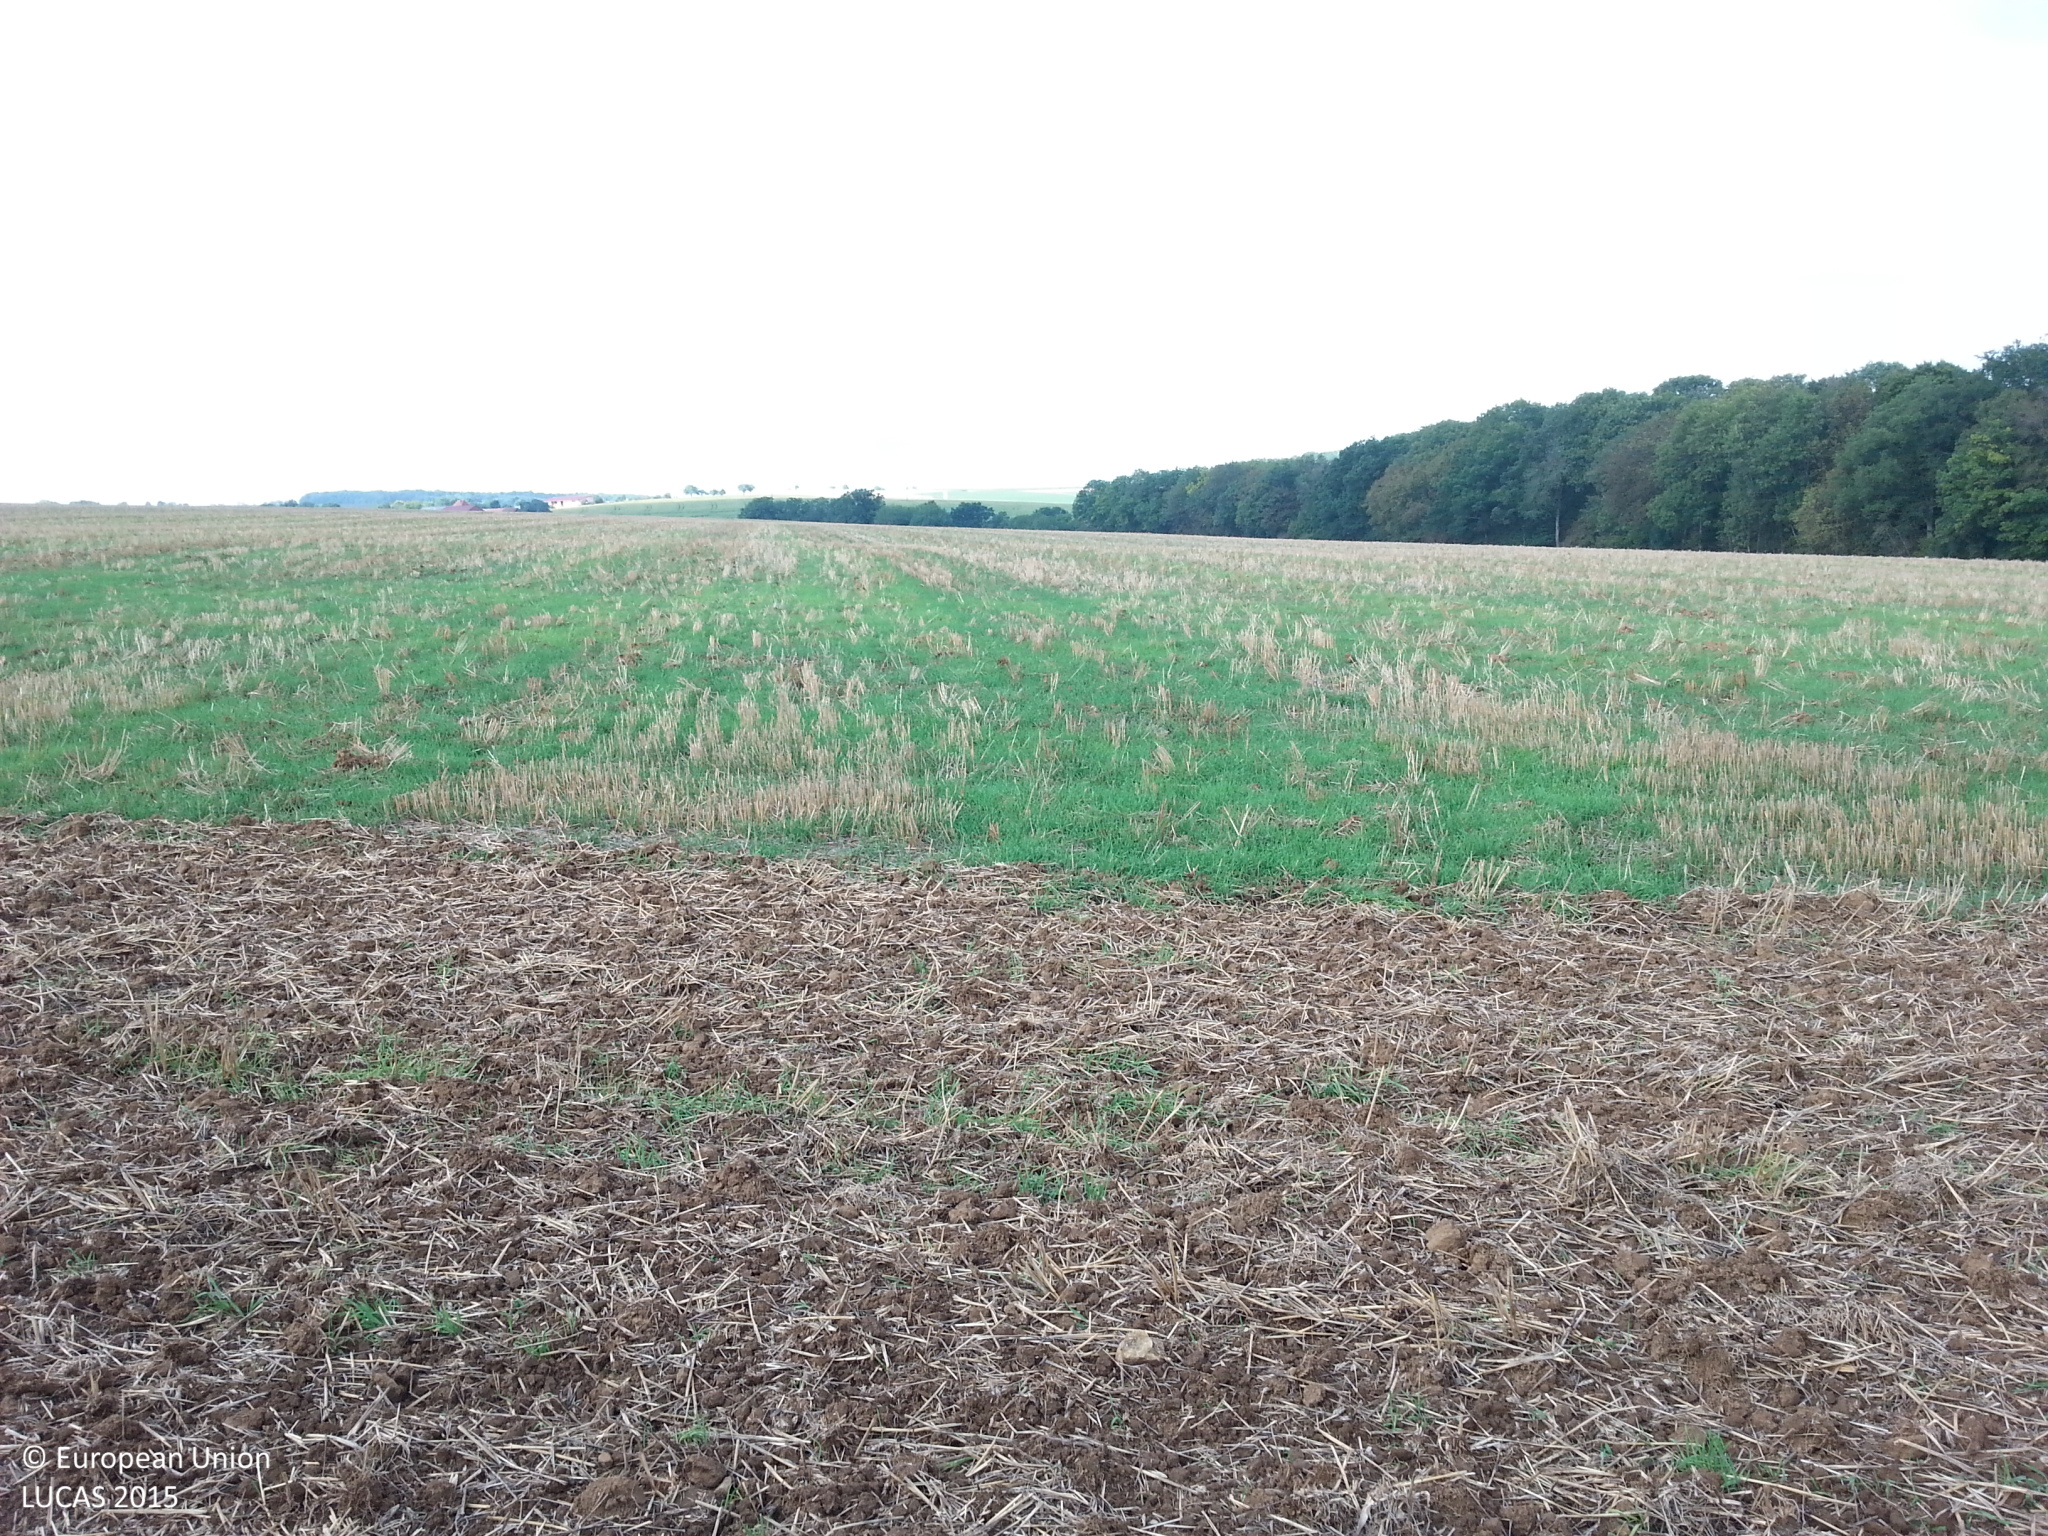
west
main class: Cropland
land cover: Maize
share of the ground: > 75 %
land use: Agriculture (excluding fallow land and kitchen gardens)
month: September
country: DE
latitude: 49.3569
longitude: 9.9587
